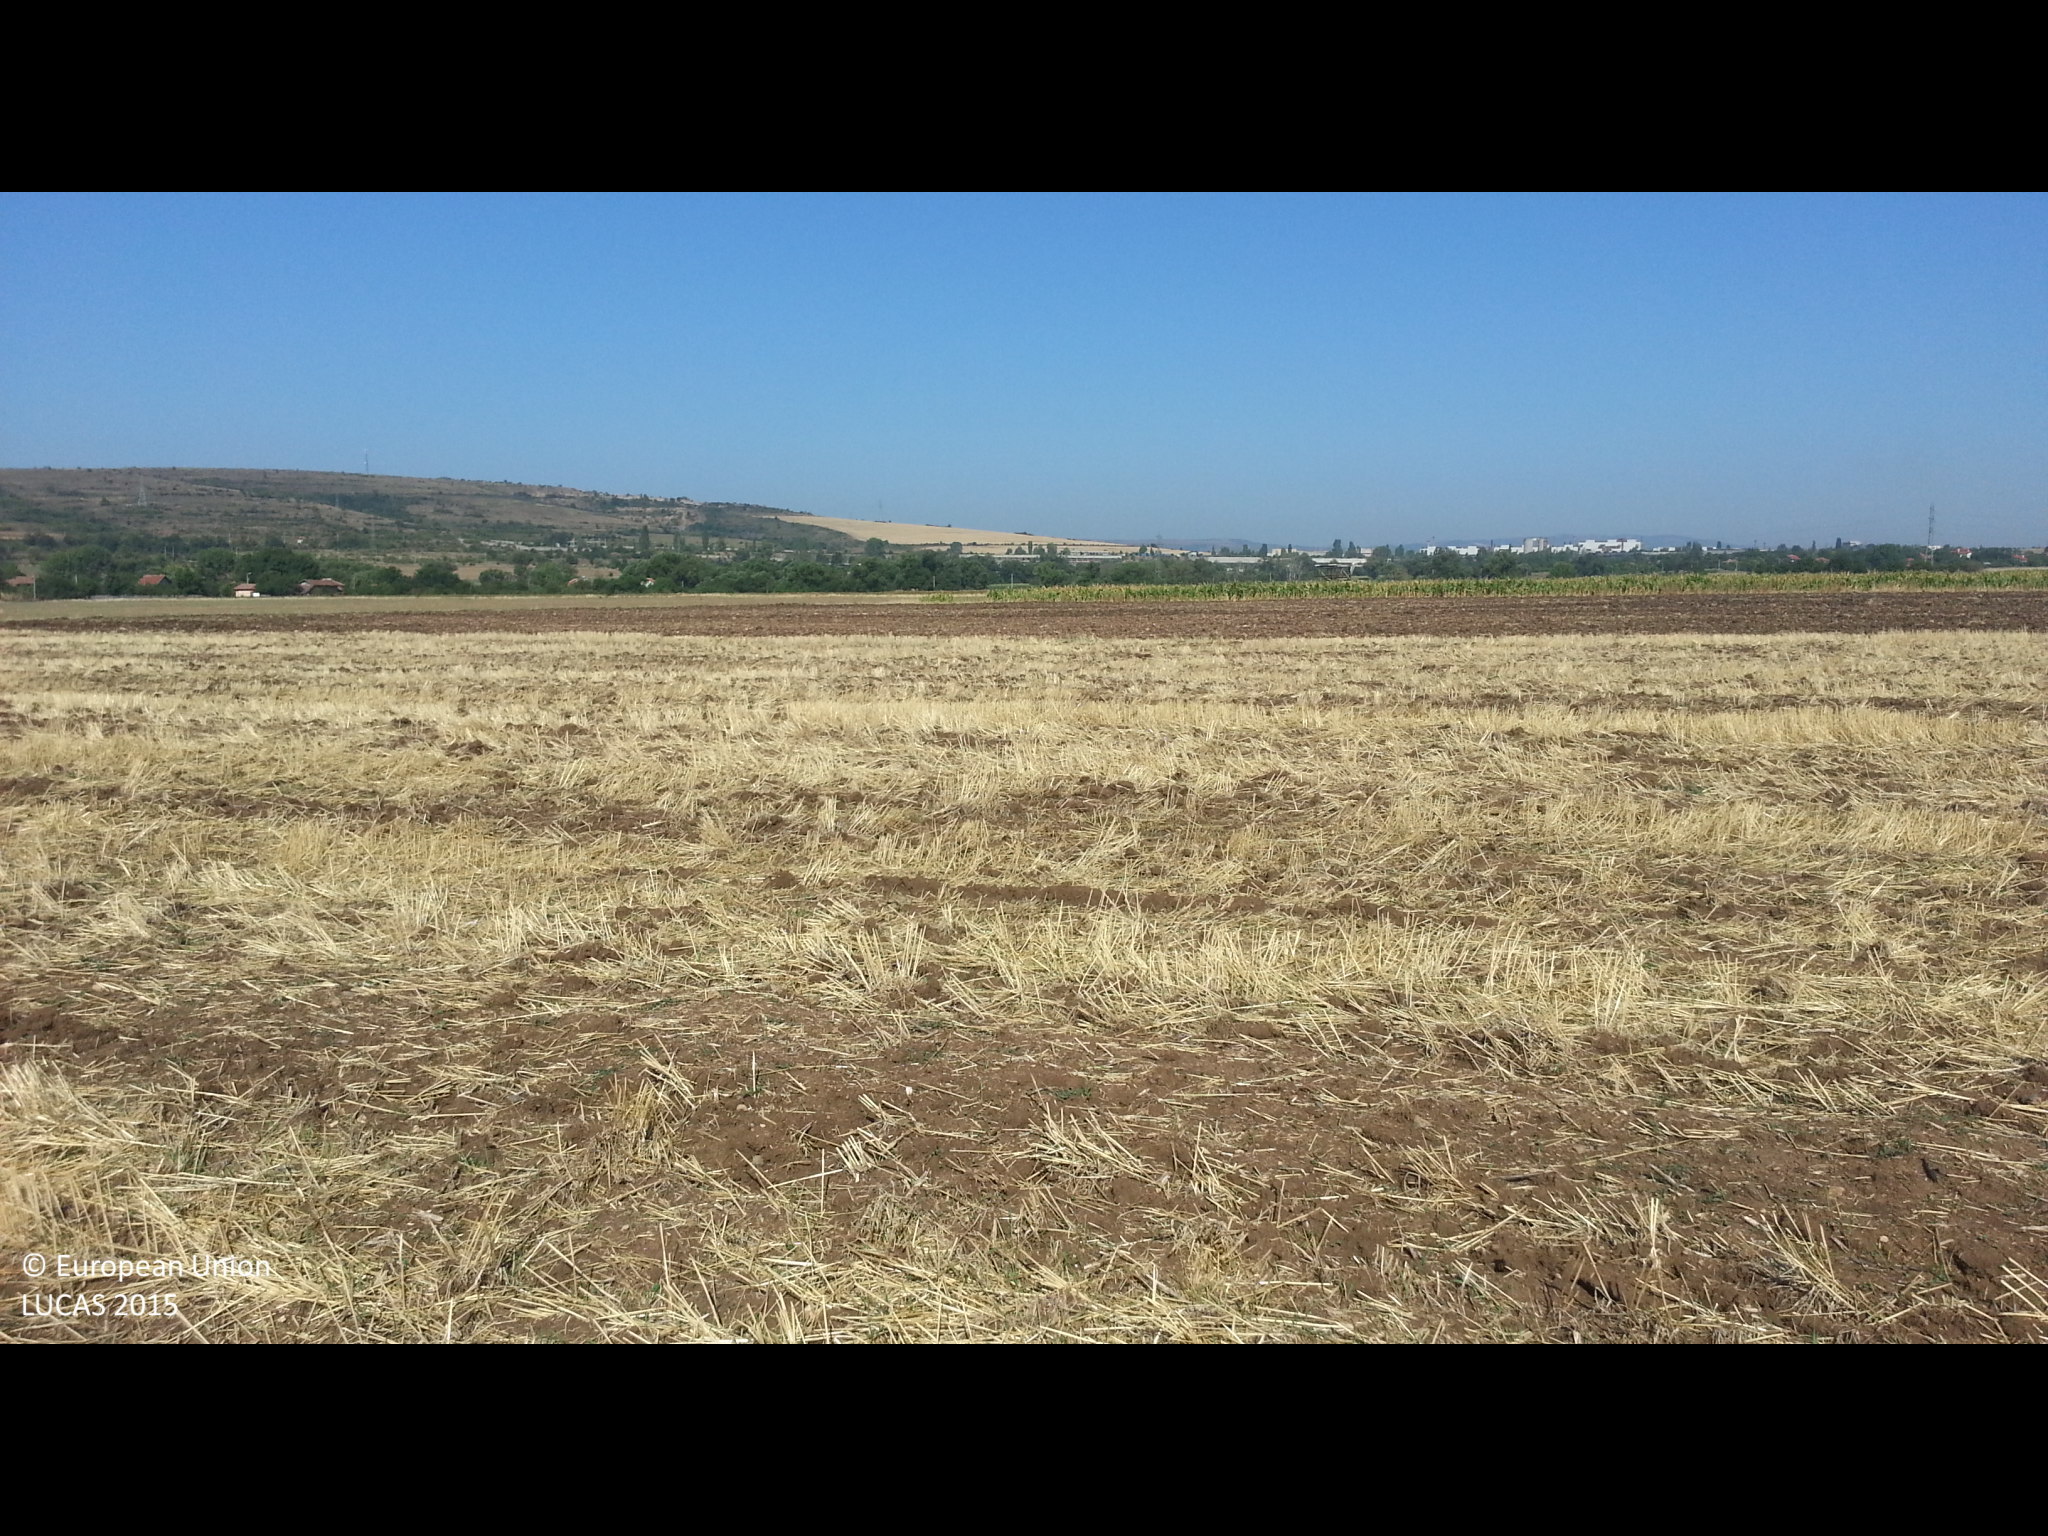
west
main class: Cropland
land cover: Common wheat
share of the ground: 25 - 50 %
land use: Agriculture (excluding fallow land and kitchen gardens)
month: August
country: BG
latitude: 42.5048
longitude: 23.0129
